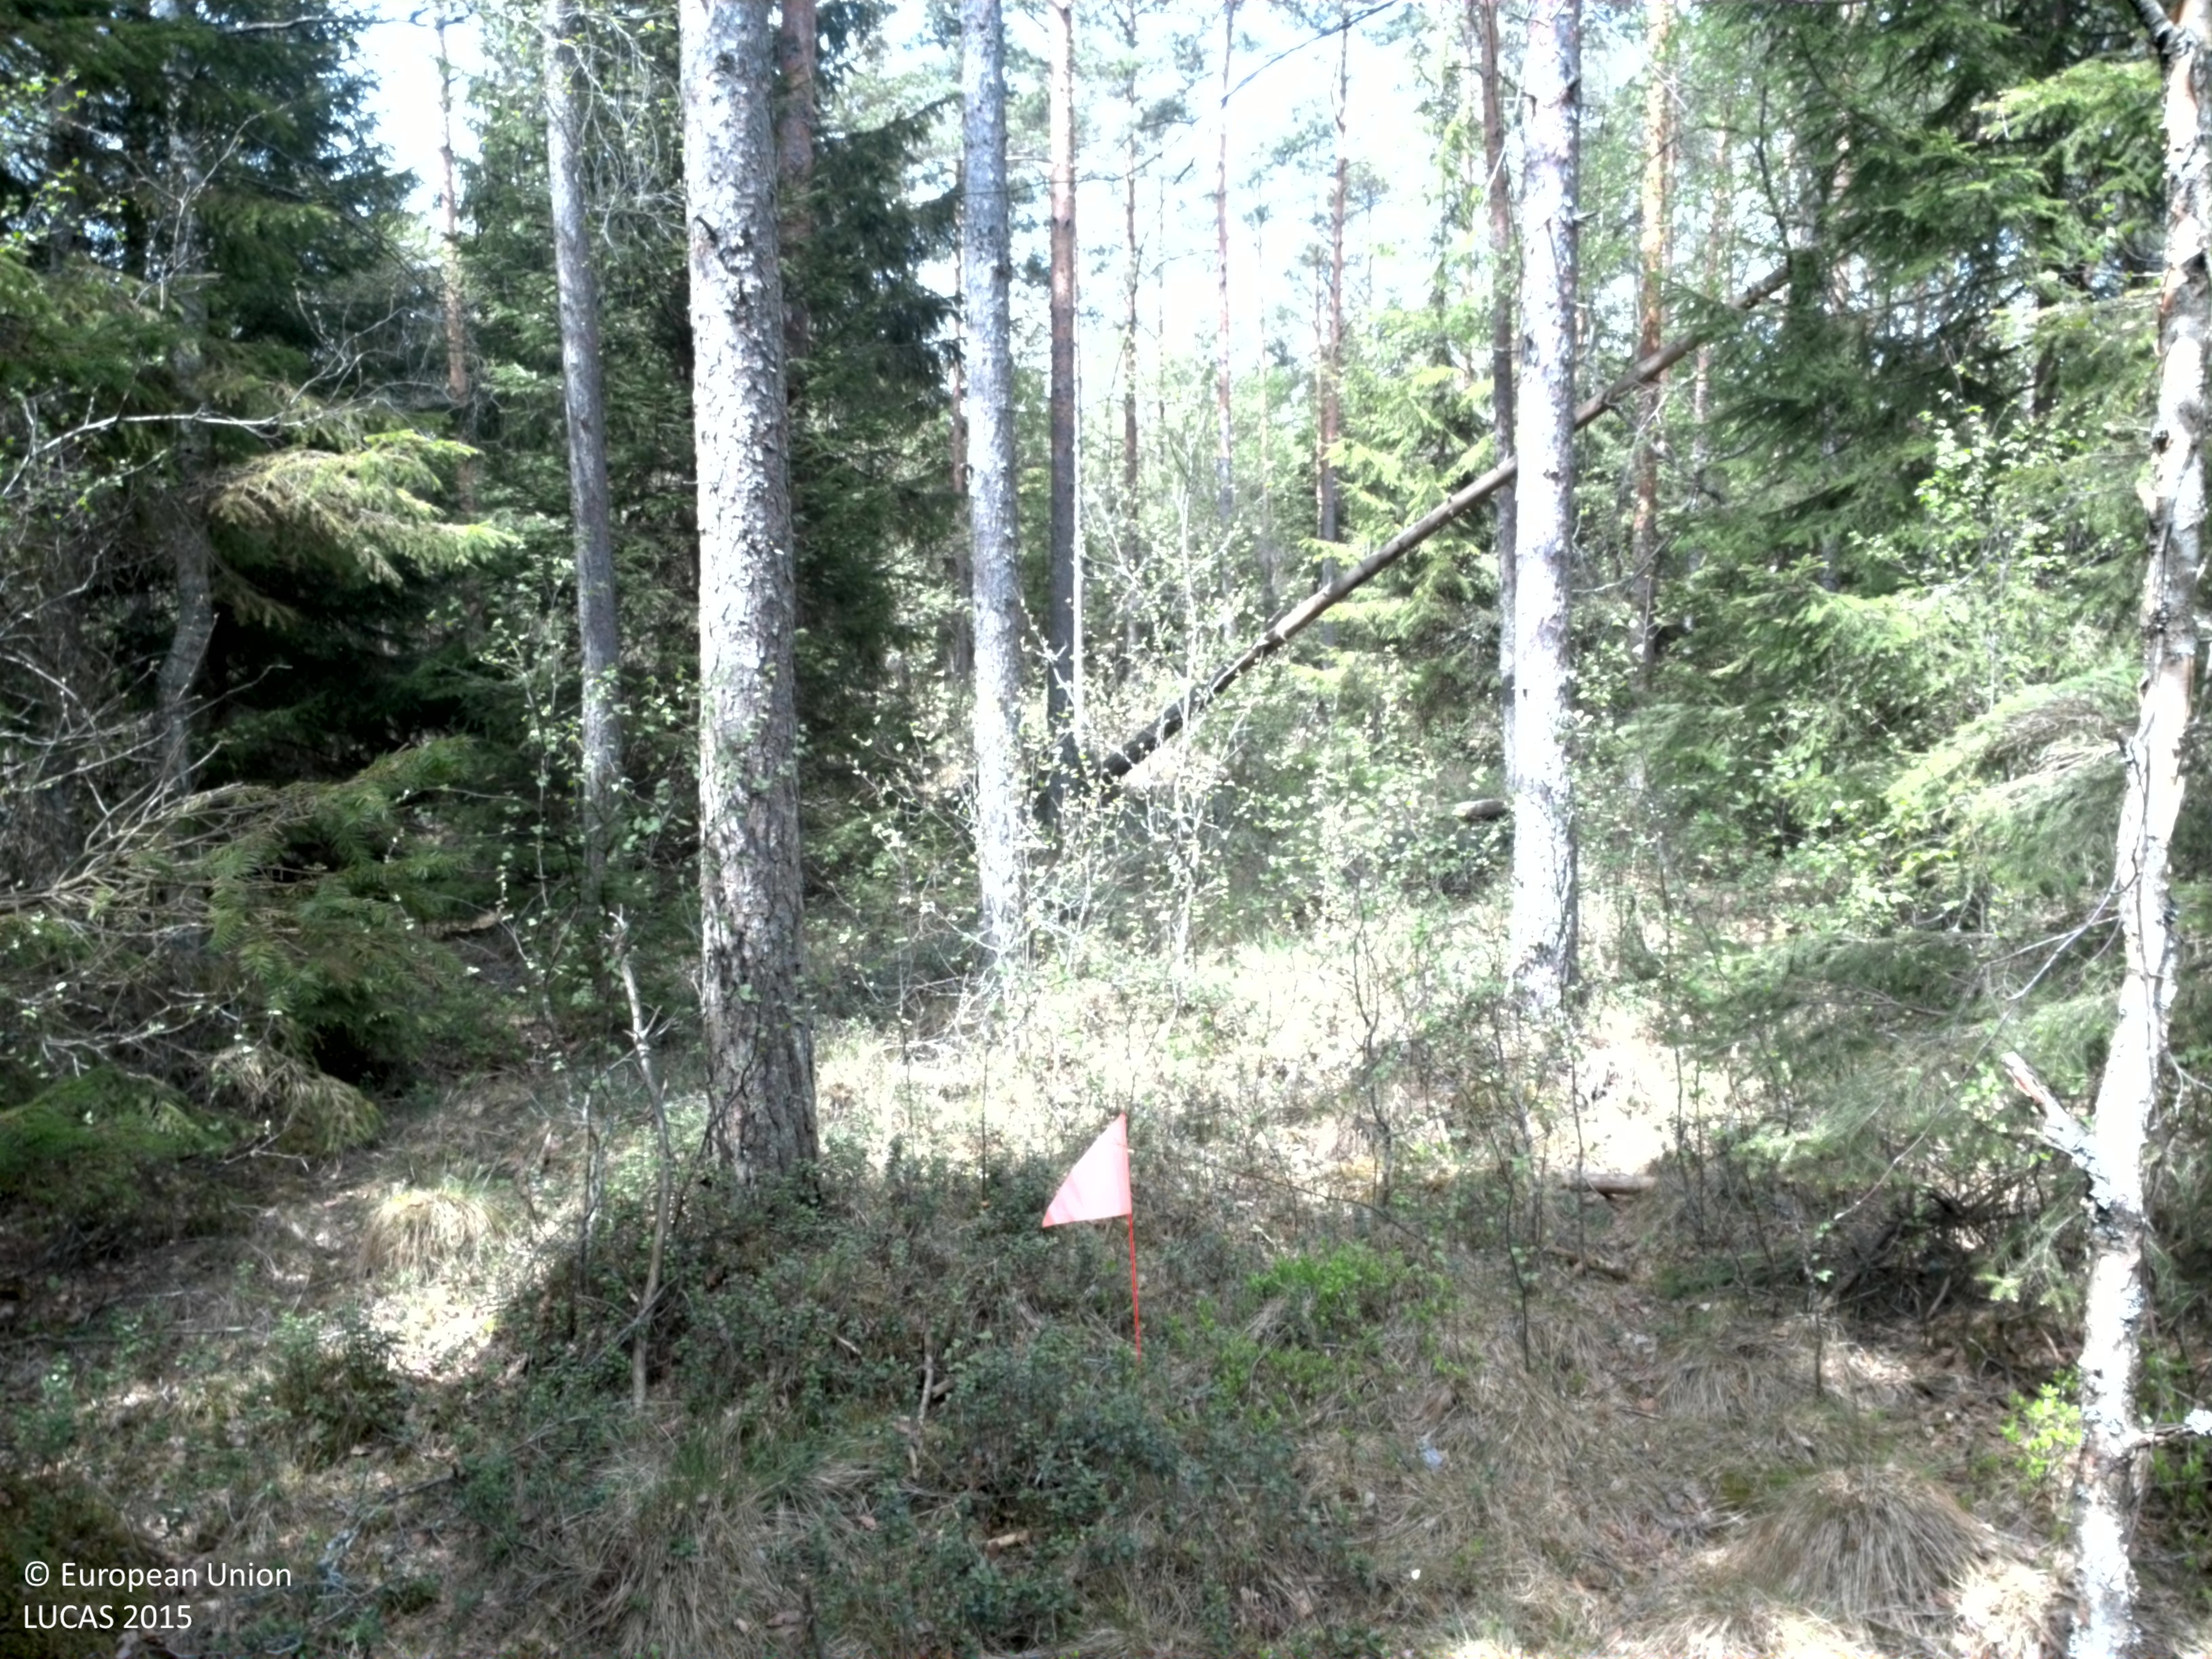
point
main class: Woodland
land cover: Pine dominated coniferous woodland
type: boreal forest
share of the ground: > 75 %
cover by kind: coniferous forest trees 60 %, broadleaved forest trees 20 %, shrubs 10 %, lichens and mosses 10 %
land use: Forestry
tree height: > 5 m
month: May
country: SE
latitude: 56.9125
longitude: 15.1712
